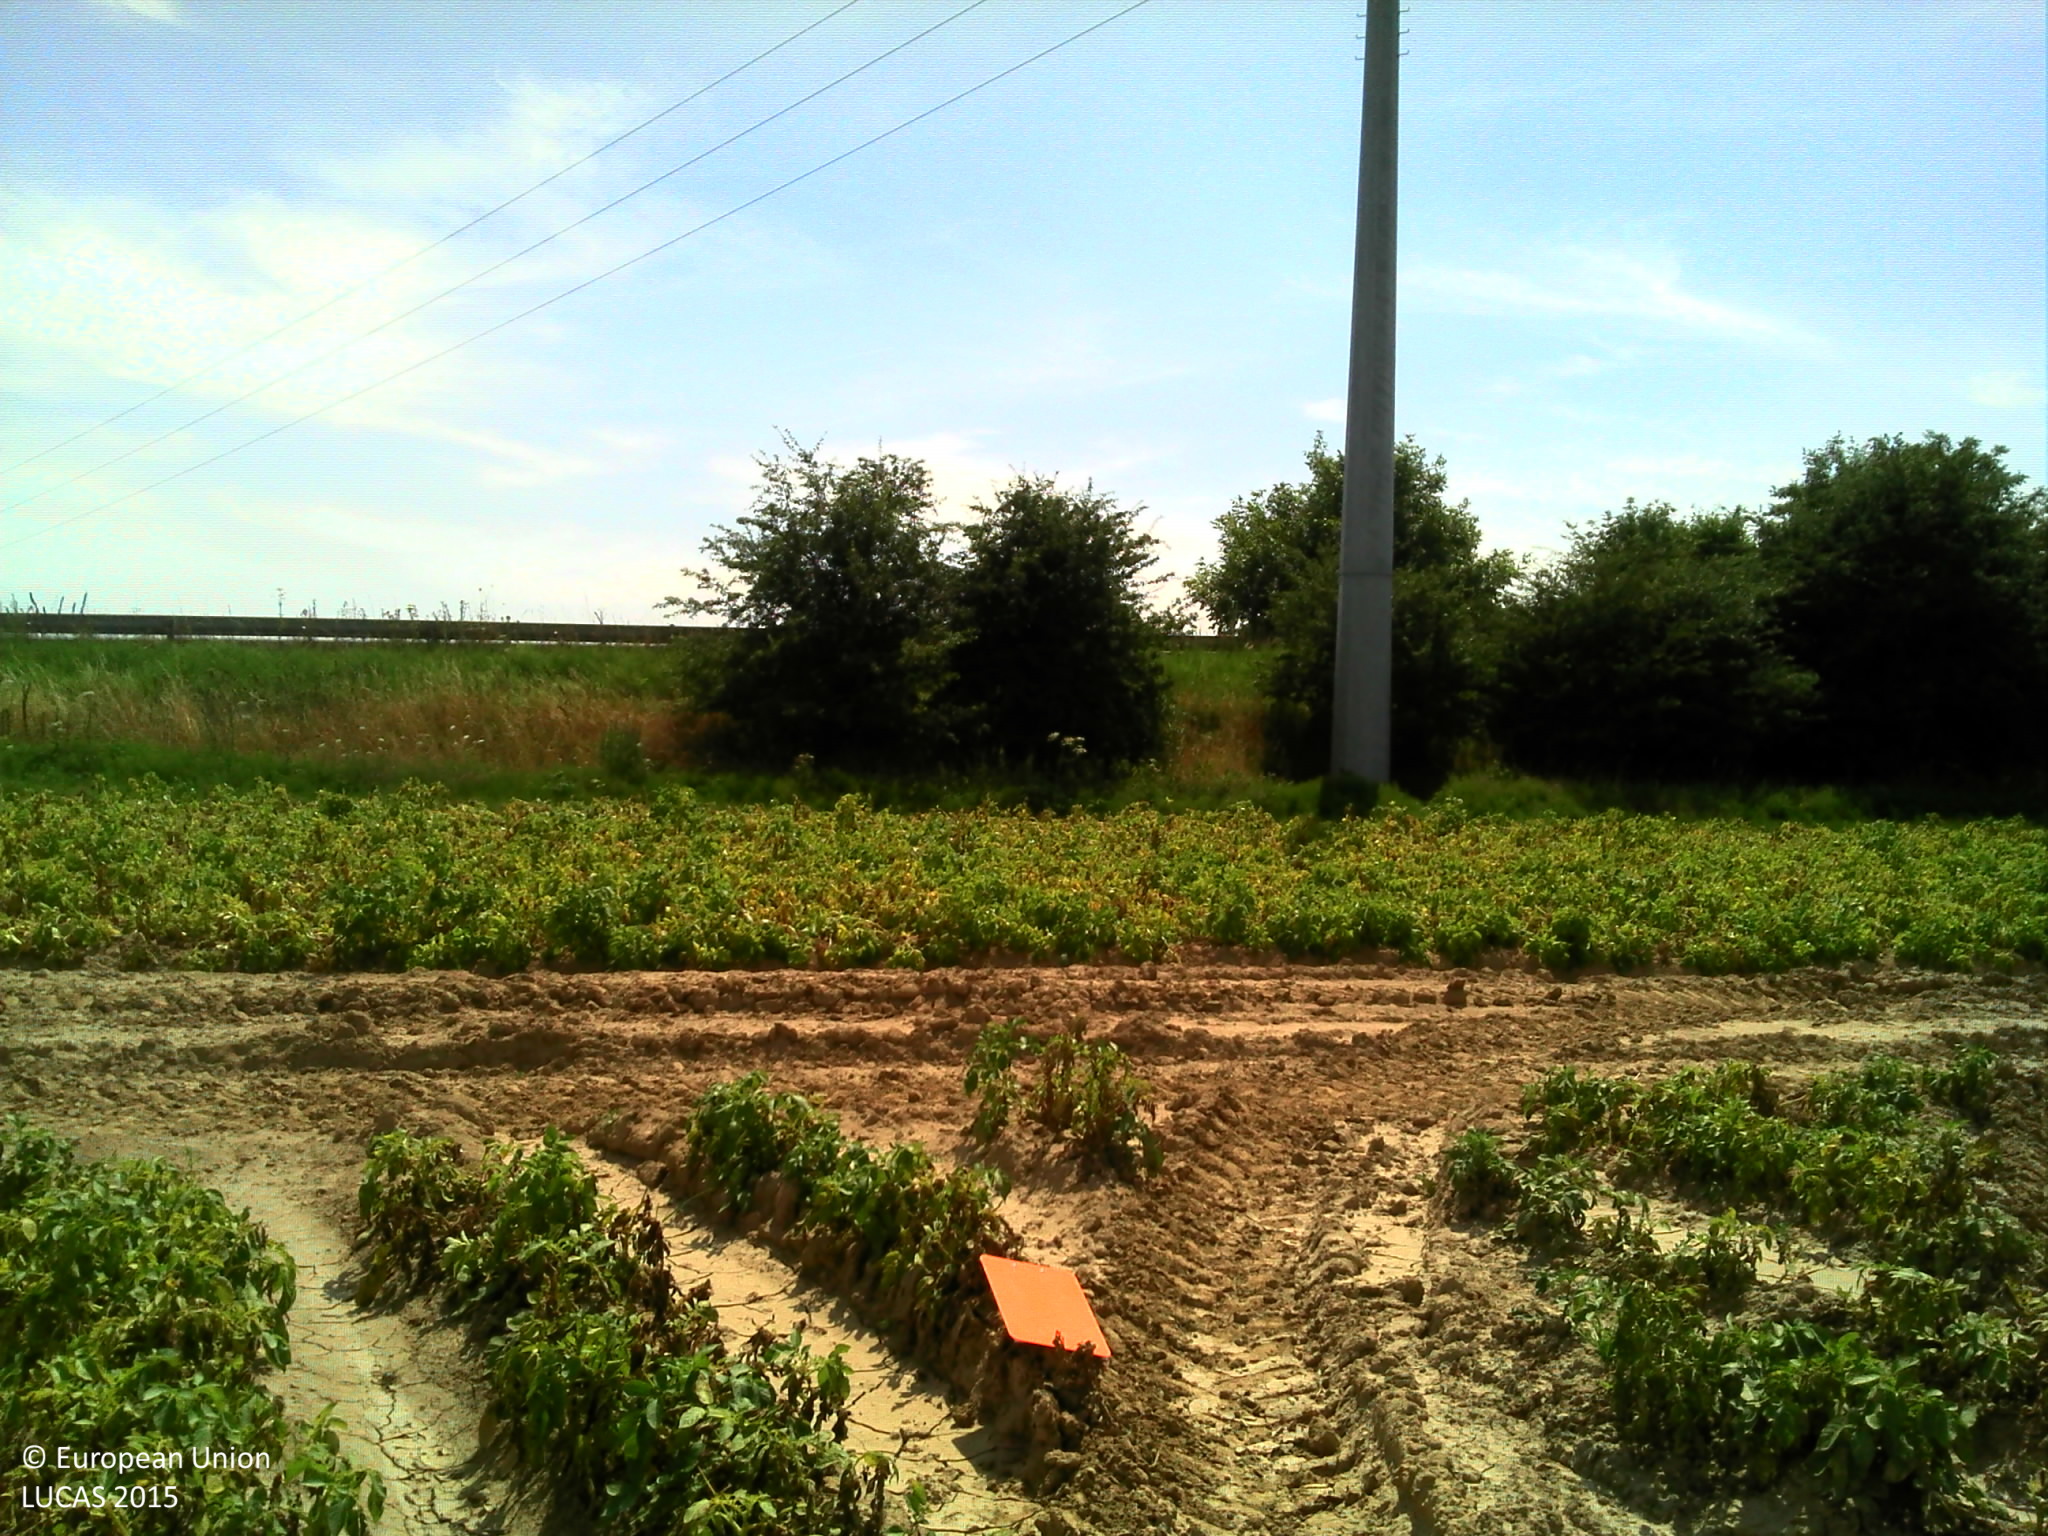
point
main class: Cropland
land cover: Potatoes
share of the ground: 25 - 50 %
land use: Agriculture (excluding fallow land and kitchen gardens)
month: August
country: FR
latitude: 49.7390
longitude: 2.7877
